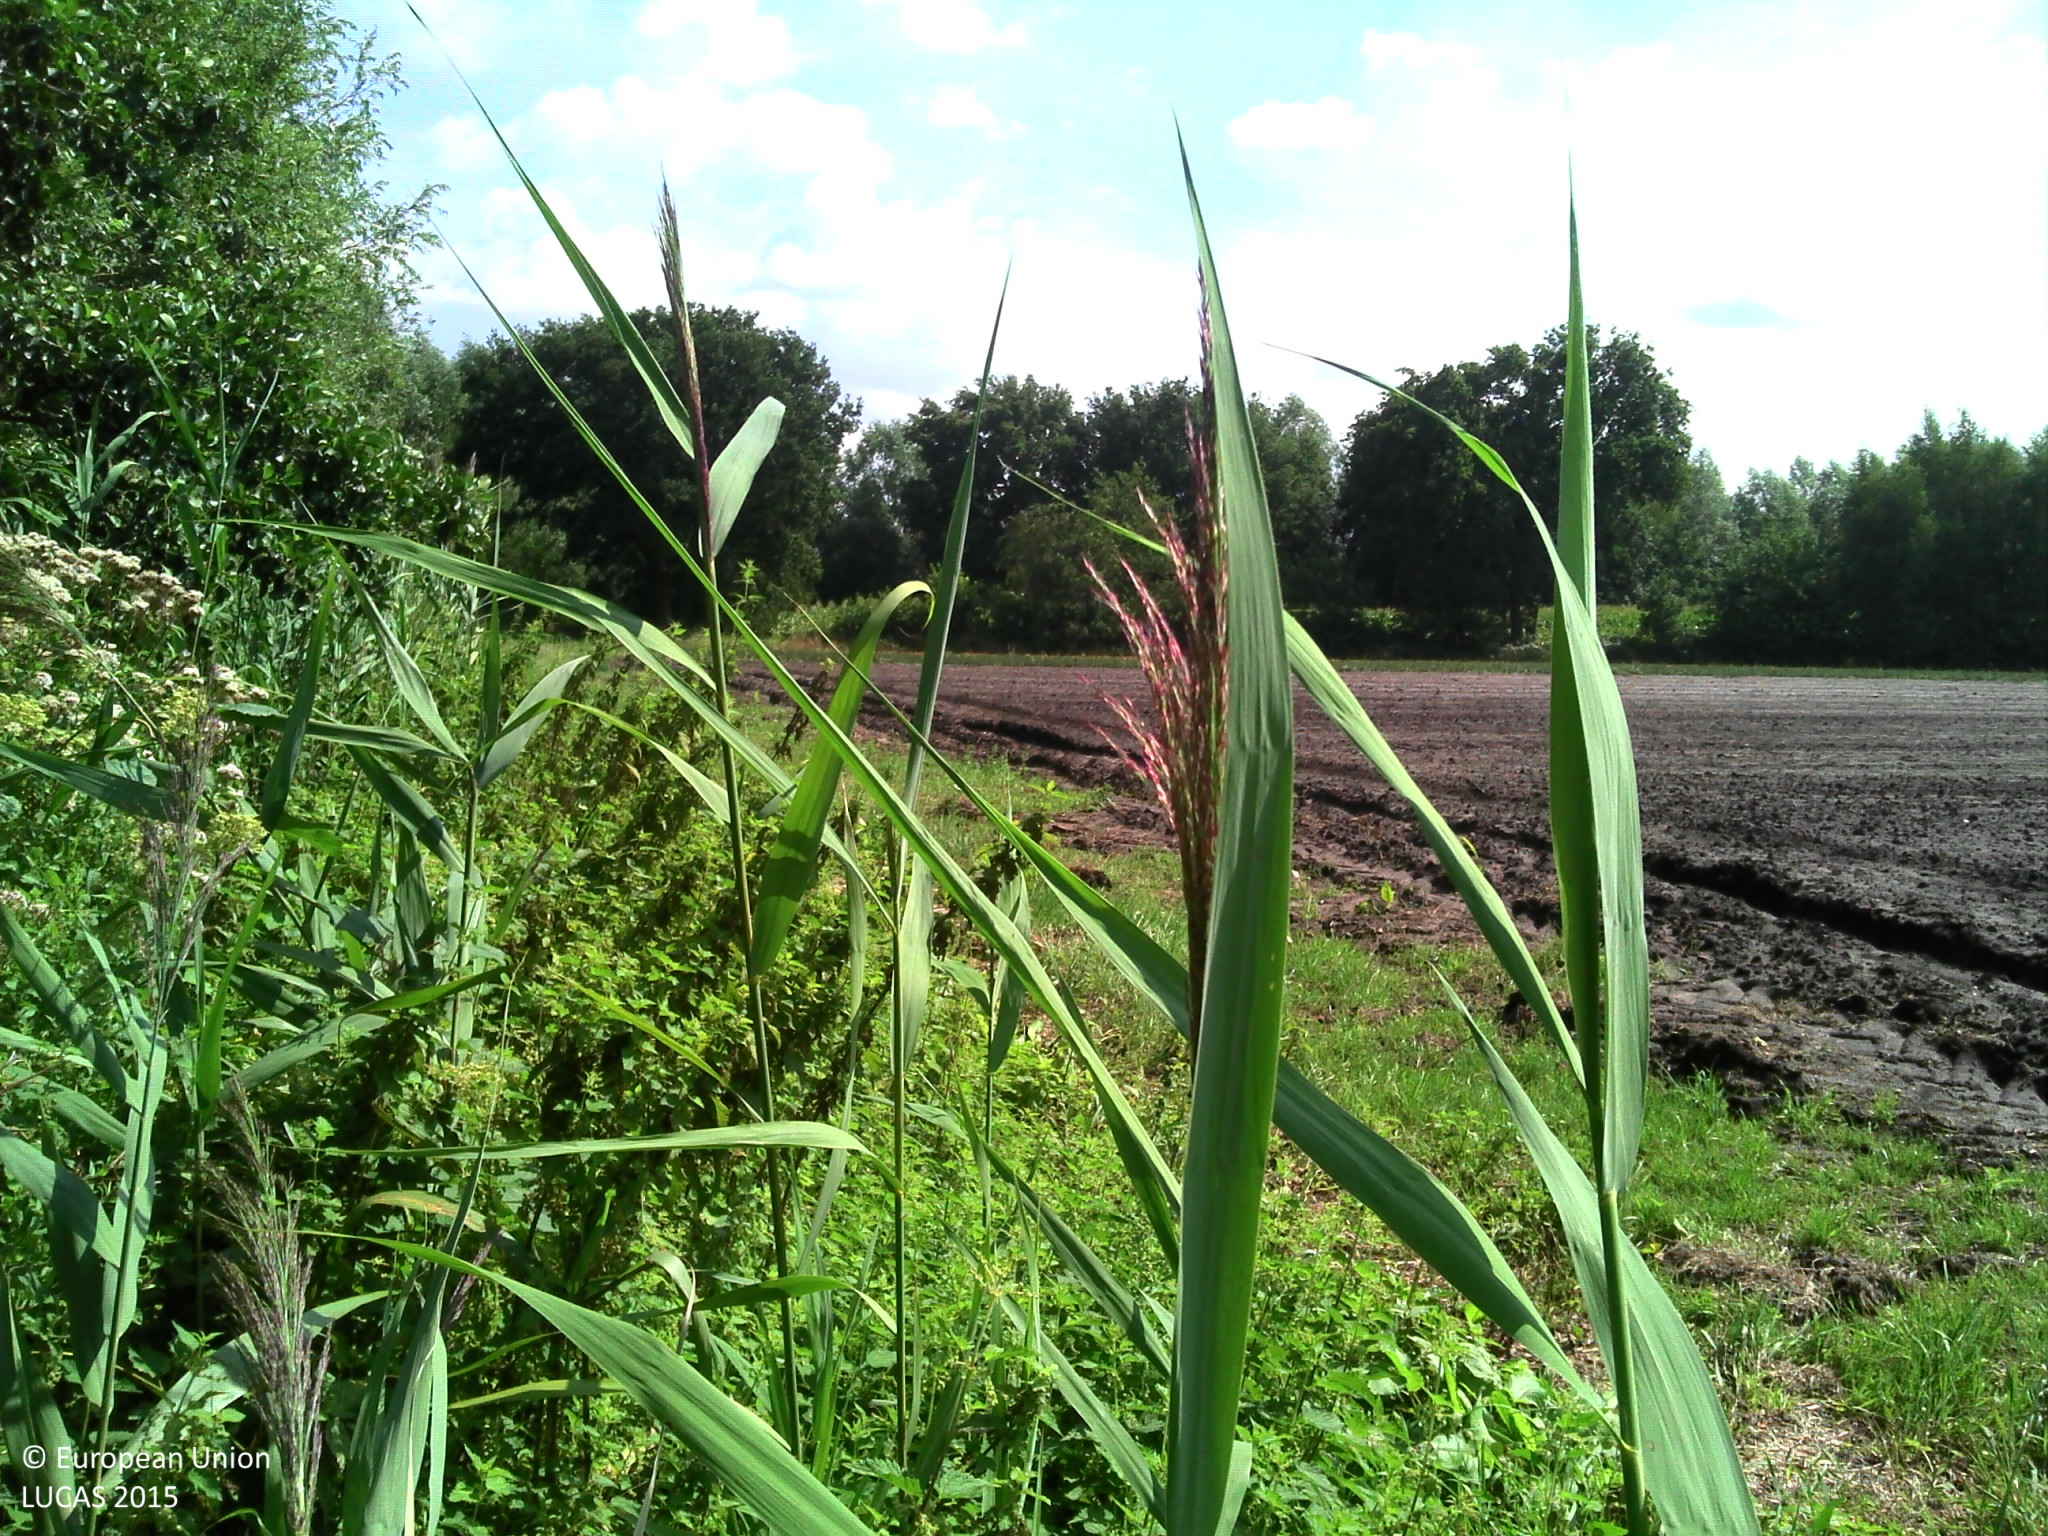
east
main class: Woodland
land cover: Broadleaved woodland
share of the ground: > 75 %
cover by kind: broadleaved forest trees 90 %, herbaceous plants 10 %
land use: Forestry
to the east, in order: Broadleaved woodland; Ditches and canals; Grass margins; Other bare soil; Spontaneously vegetated surfaces; Broadleaved woodland; Spontaneously vegetated surfaces; Rivers and streams; Broadleaved woodland; Grass margins; Fences; Grass margins; Tracks; Grass margins; Fences; Spontaneously vegetated surfaces; Fences; Spontaneously vegetated surfaces; Inland fresh water bodies
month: August
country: BE
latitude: 51.2336
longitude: 5.1423
